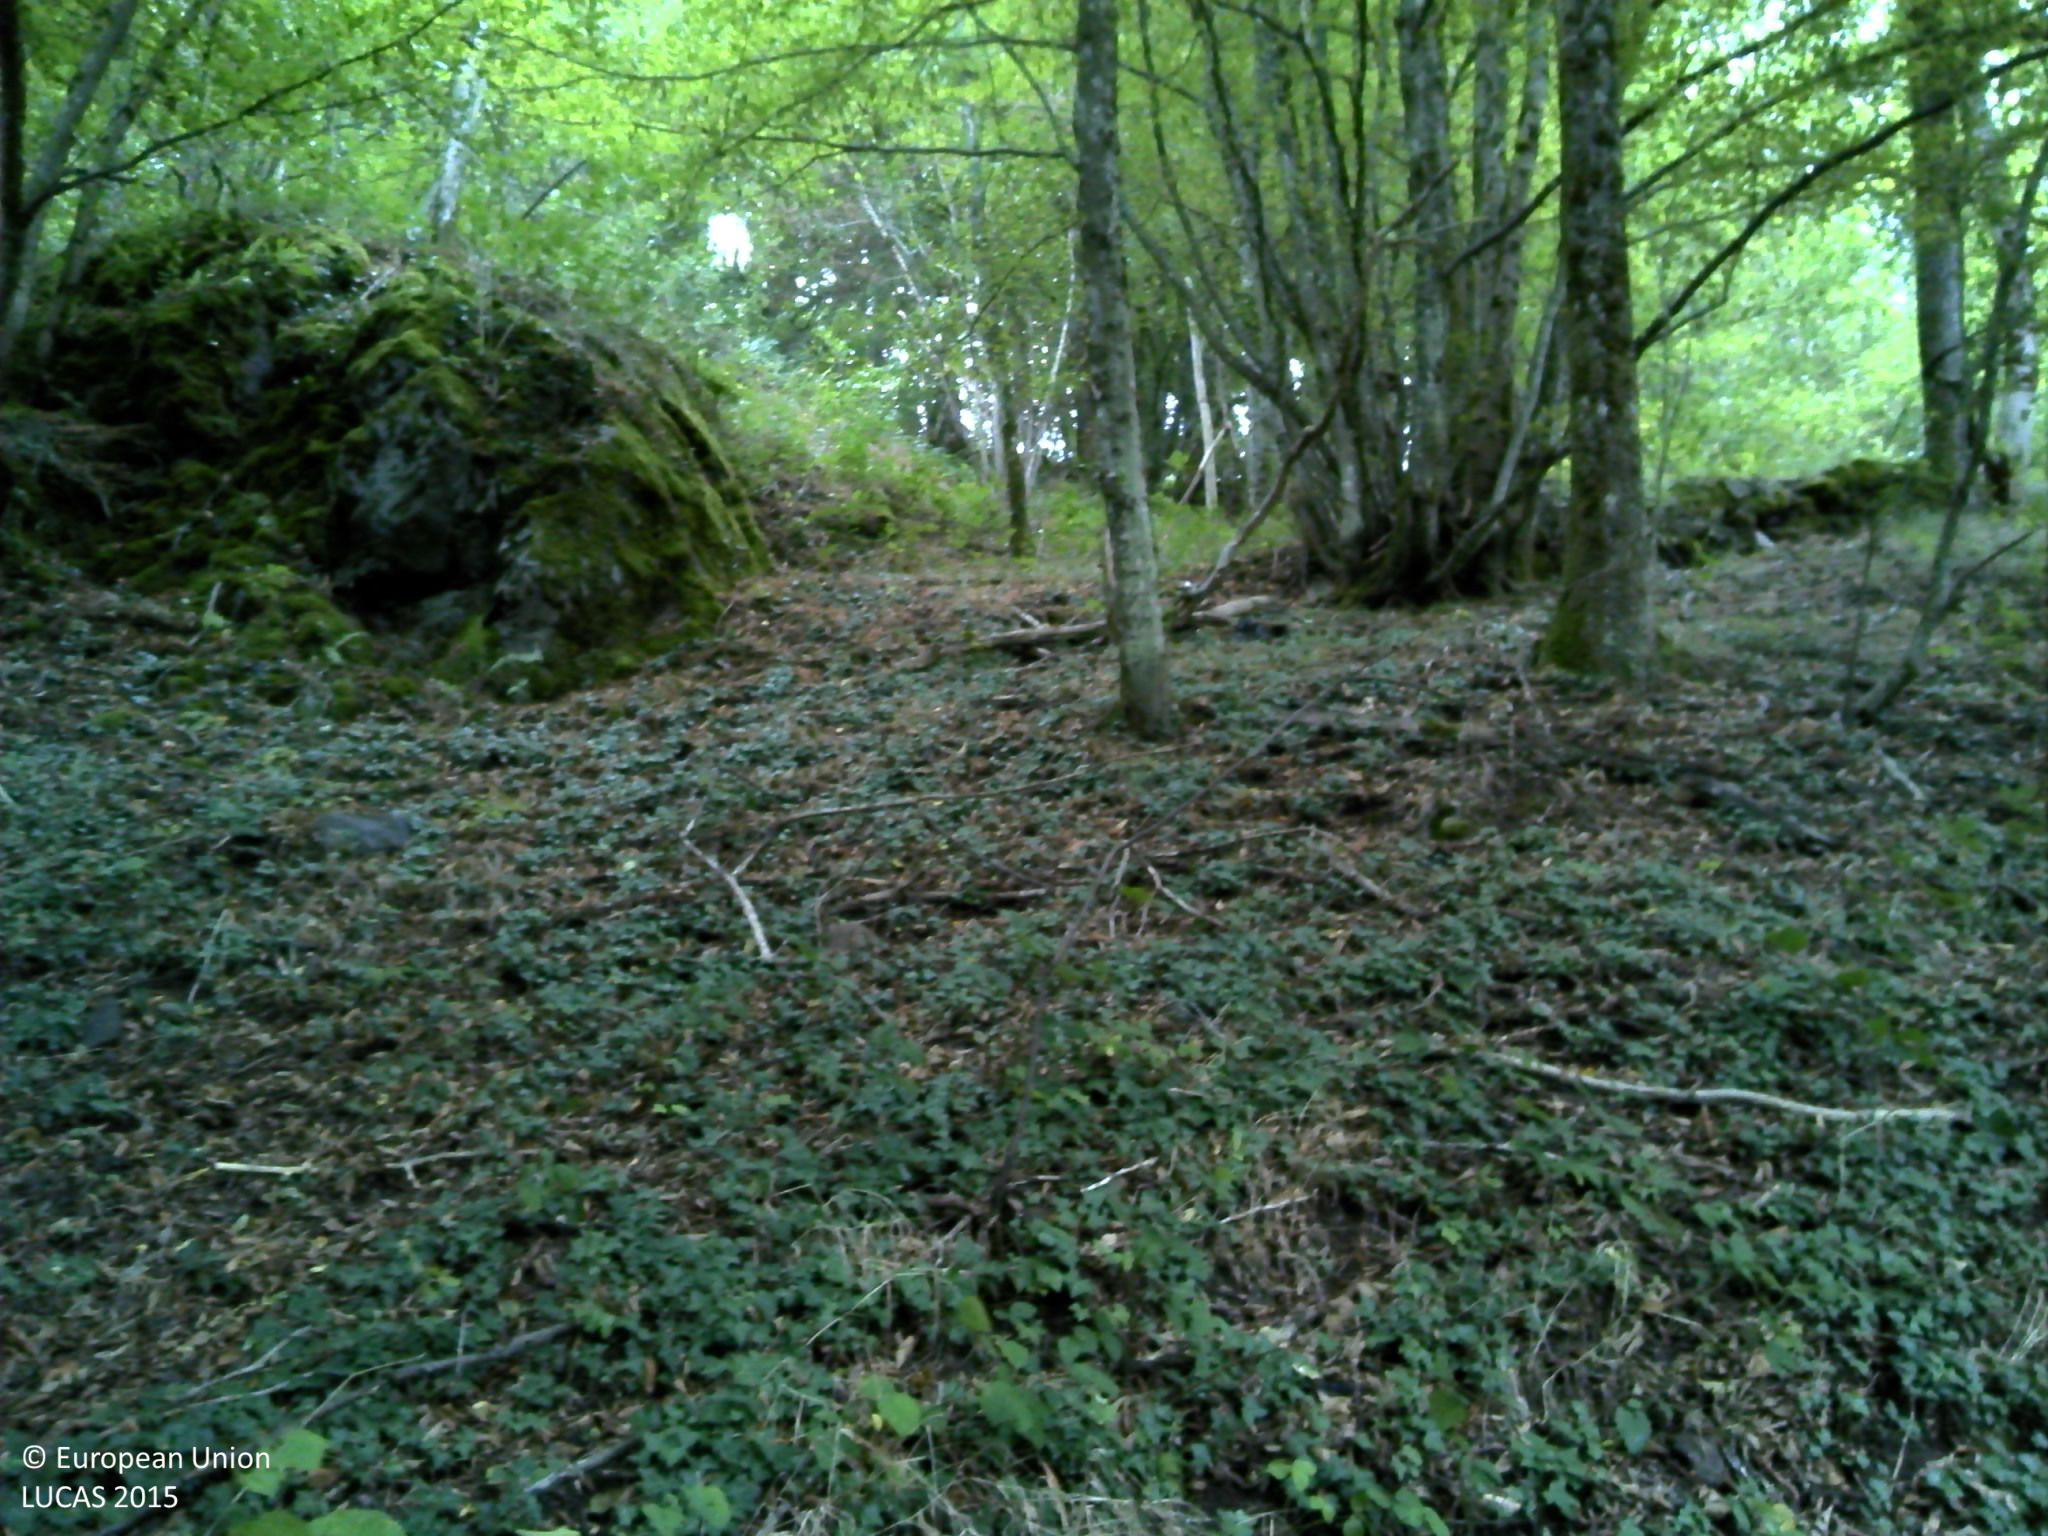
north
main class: Woodland
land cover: Broadleaved woodland
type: mesophytic deciduous forest
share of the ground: > 75 %
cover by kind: broadleaved forest trees 85 %, herbaceous plants 10 %, unconsolidated bare surface 5 %
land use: Forestry
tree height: > 5 m
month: August
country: FR
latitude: 47.9618
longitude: 6.8271
